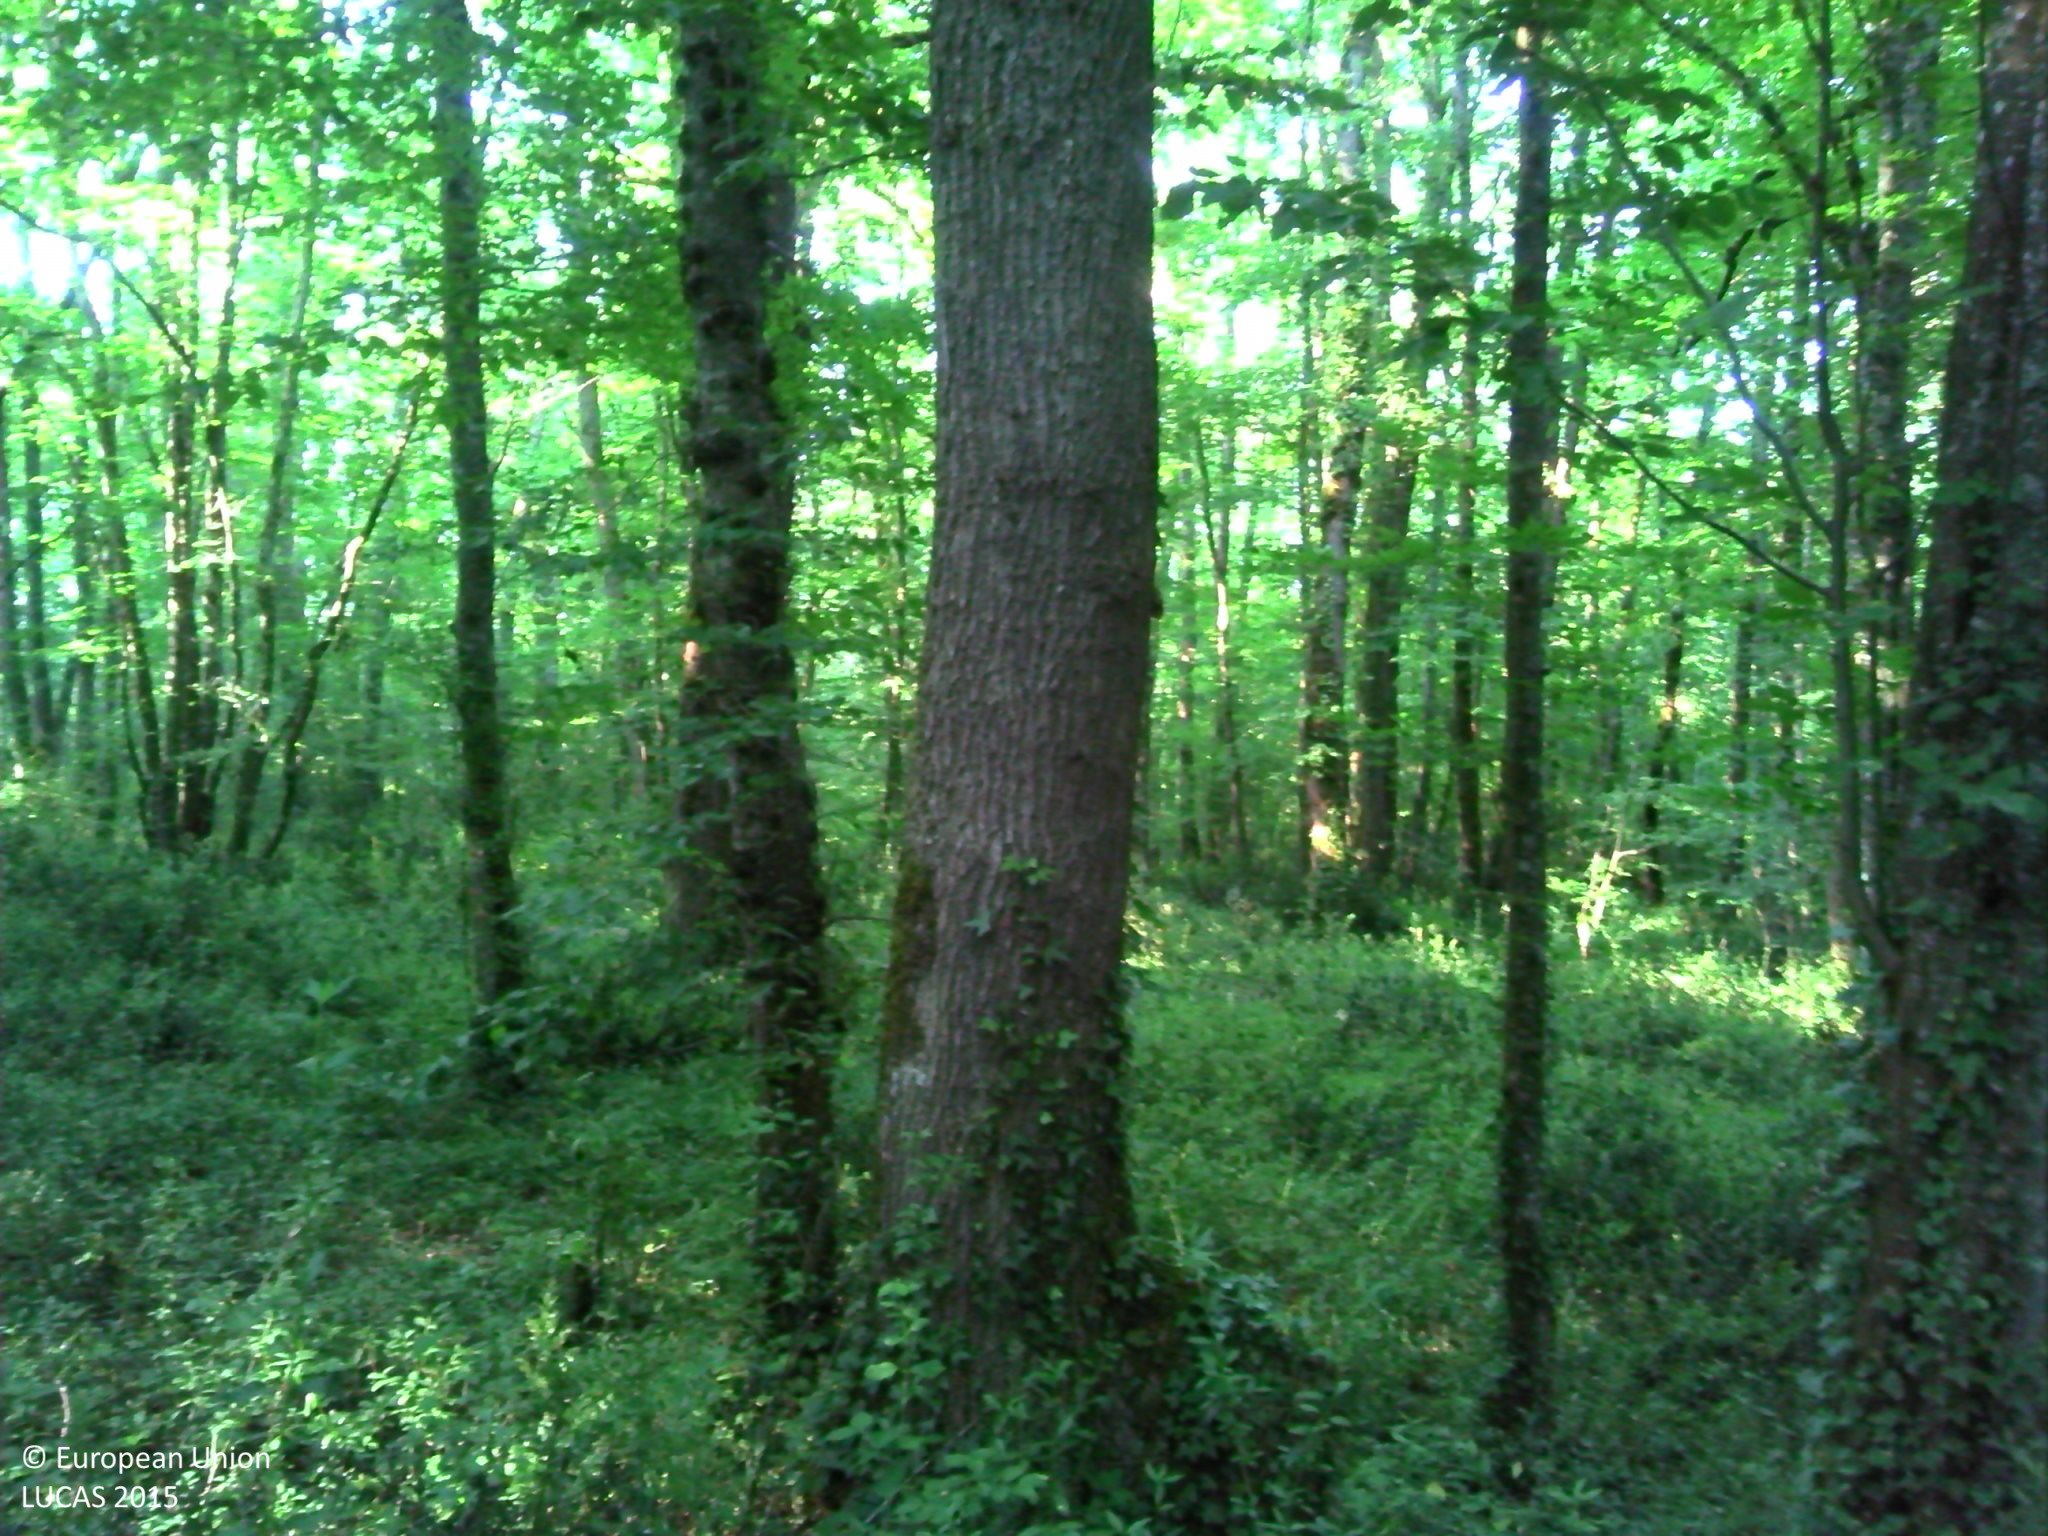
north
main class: Woodland
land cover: Broadleaved woodland
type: mesophytic deciduous forest
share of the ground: > 75 %
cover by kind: broadleaved forest trees 85 %, shrubs 10 %, herbaceous plants 5 %
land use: Forestry
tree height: > 5 m
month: June
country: FR
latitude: 43.6944
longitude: 0.6801
